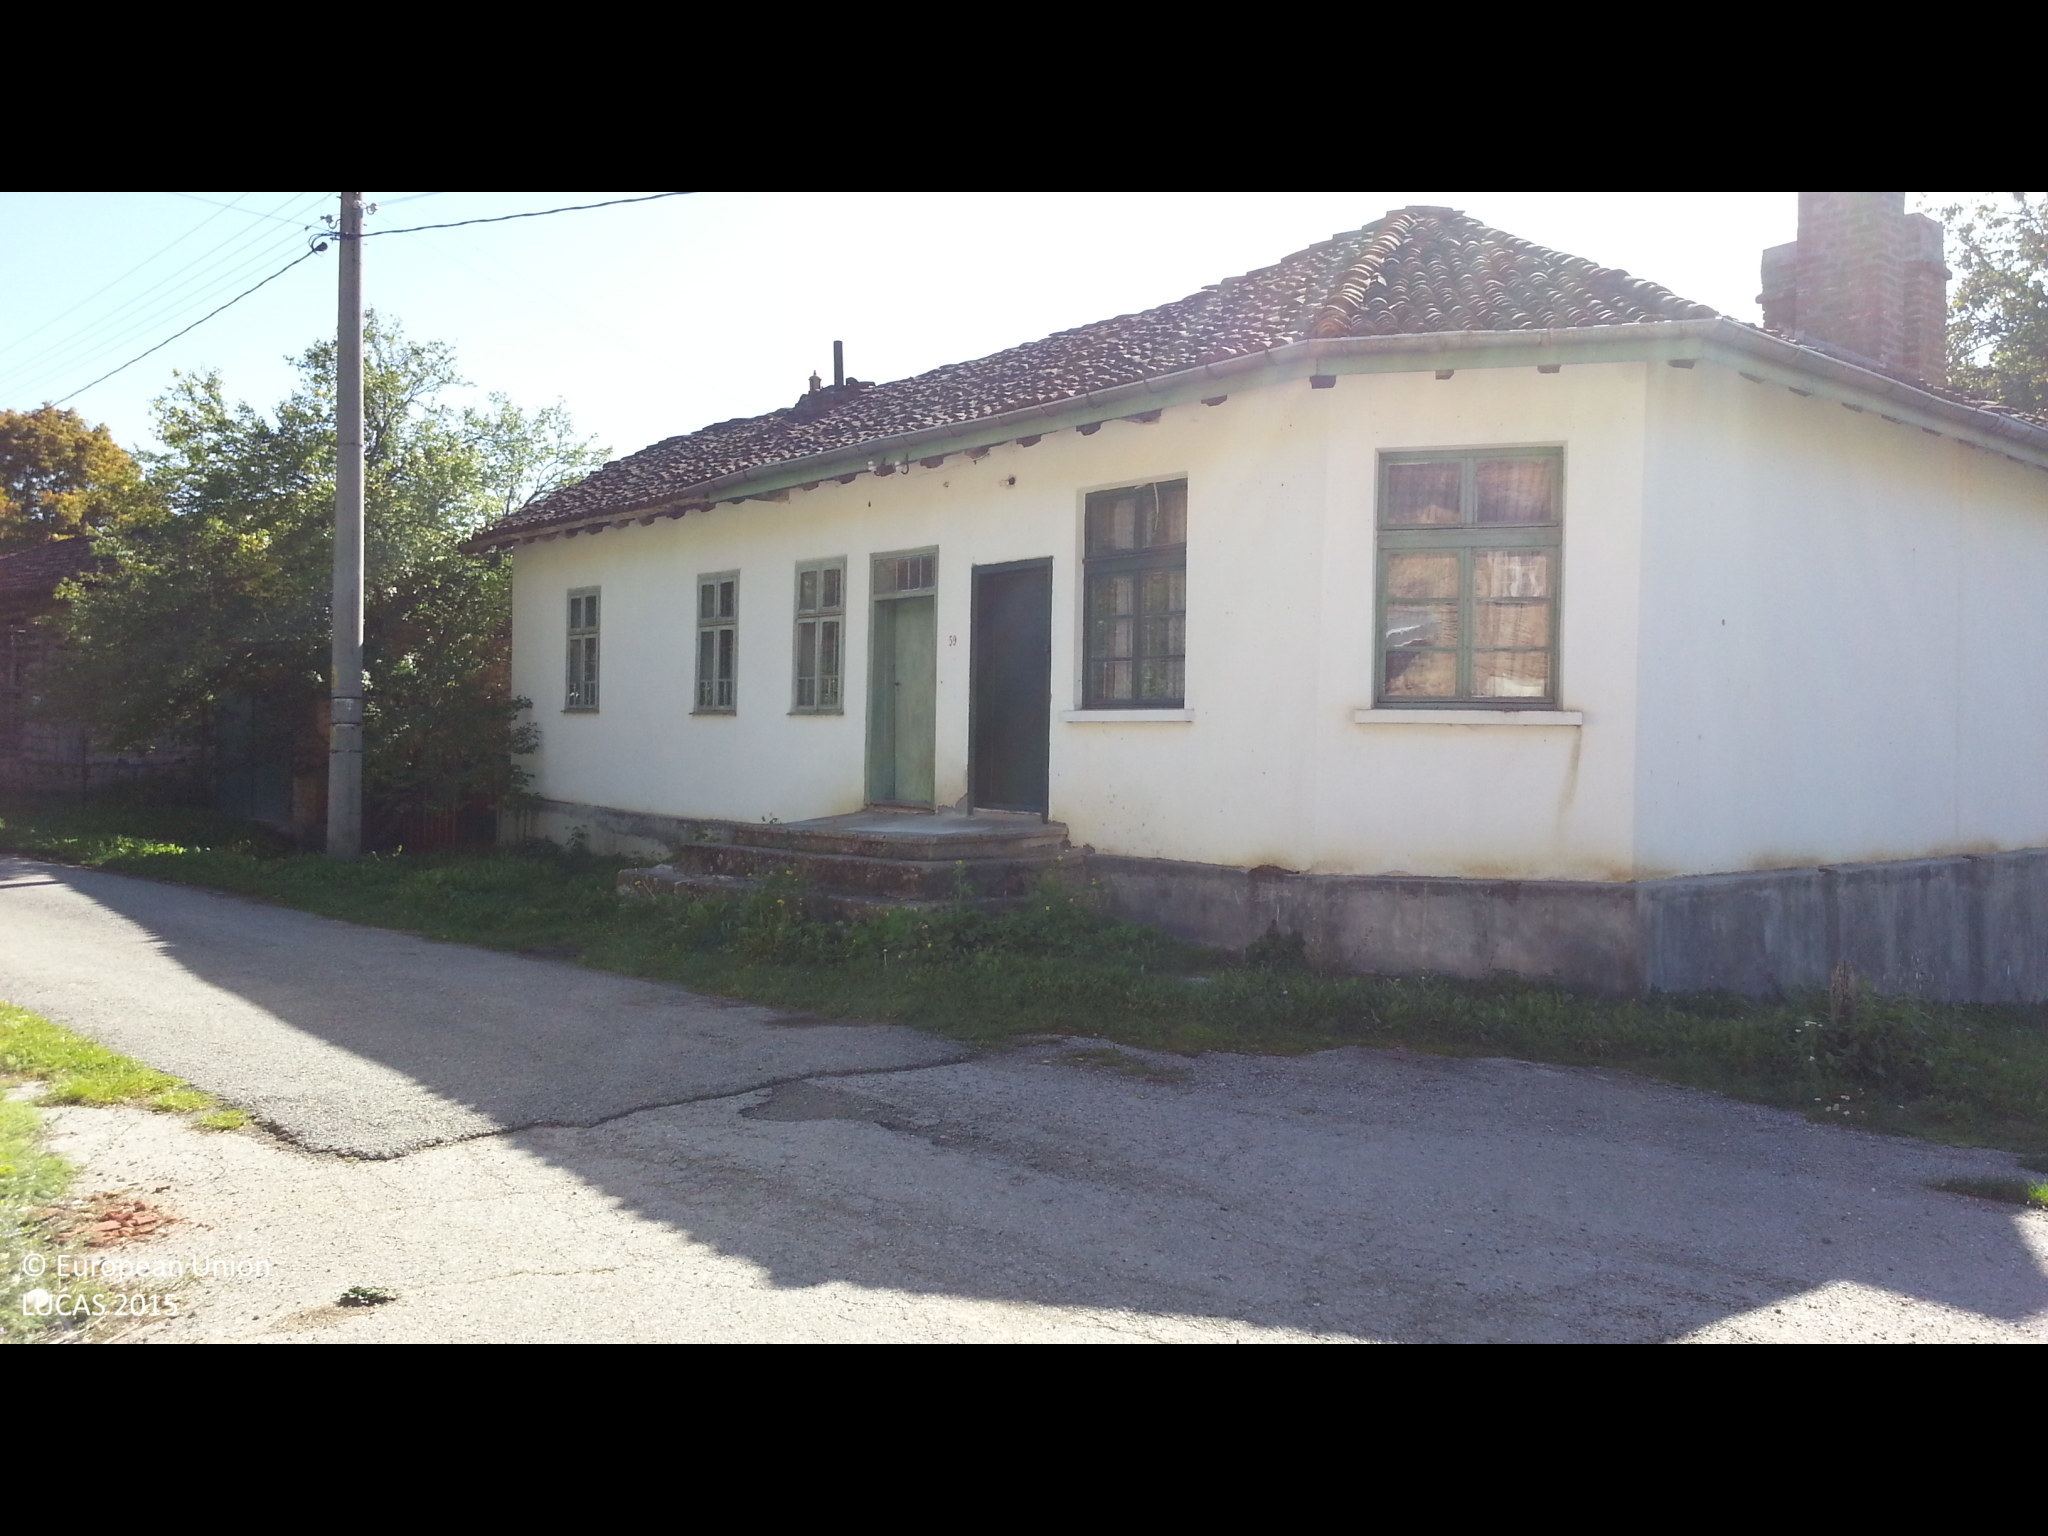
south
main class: Grassland
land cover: Grassland with sparse tree/shrub cover
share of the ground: > 75 %
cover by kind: herbaceous plants 90 %, broadleaved forest trees 5 %, shrubs 5 %
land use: Residential
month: October
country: BG
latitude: 42.6487
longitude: 22.5997
